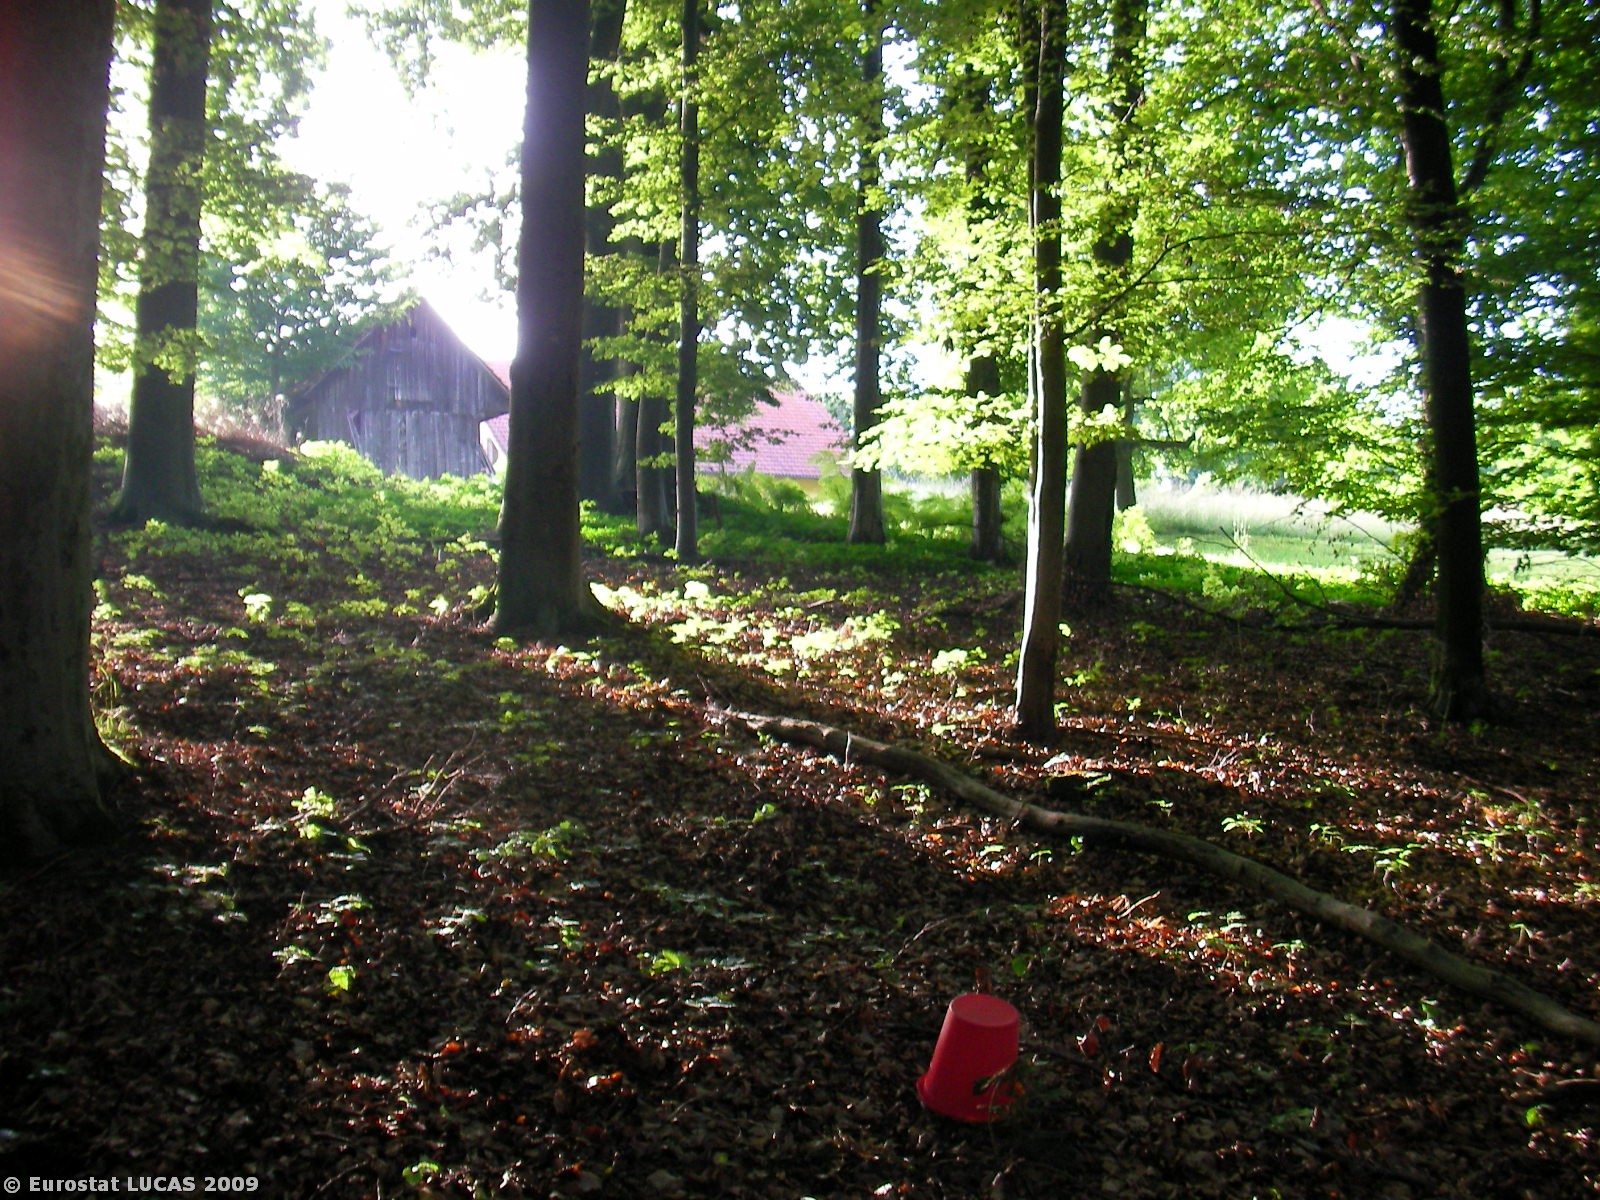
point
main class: Woodland
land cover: Broadleaved woodland
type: hemiboreal forest and nemoral coniferous forest and mixed broadleaved-coniferous forest
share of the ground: > 75 %
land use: Forestry
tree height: > 5 m
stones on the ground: < 10 %
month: June
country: AT
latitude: 47.0006
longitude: 15.5630
